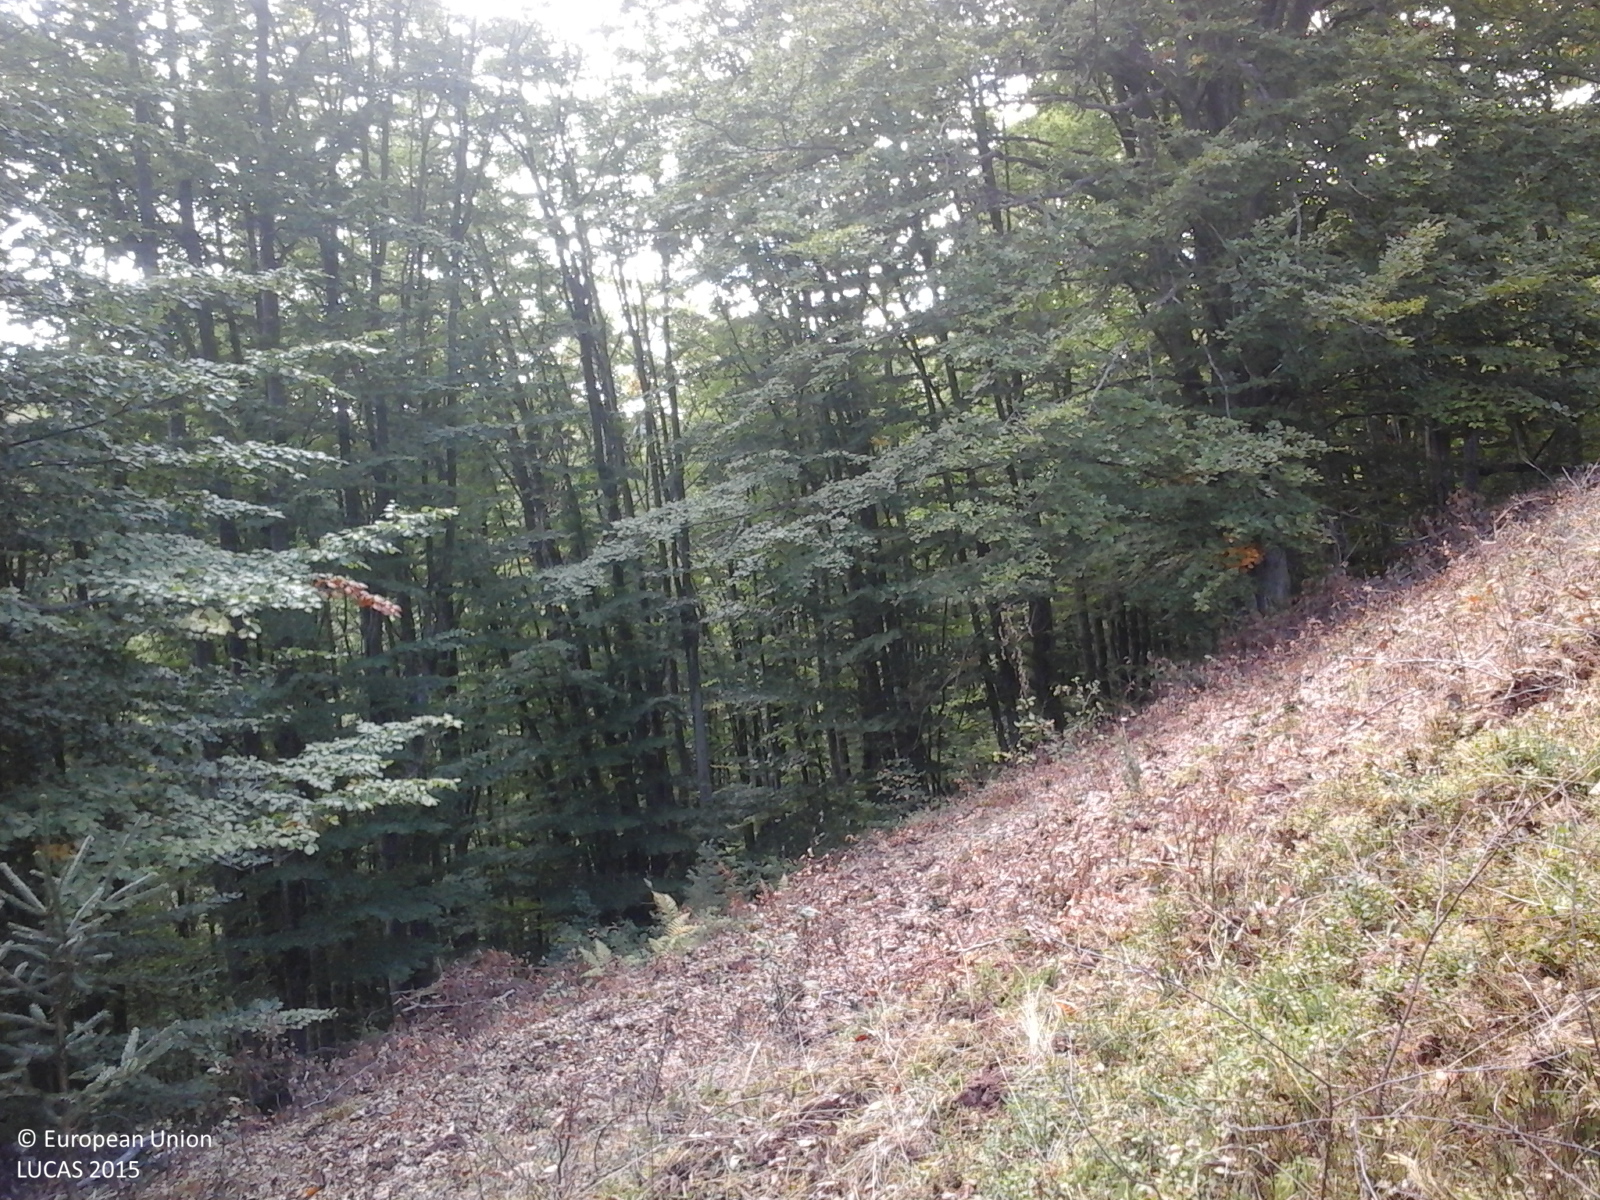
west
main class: Woodland
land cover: Broadleaved woodland
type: mesophytic deciduous forest
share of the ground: > 75 %
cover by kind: broadleaved forest trees 100 %
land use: Forestry
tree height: > 5 m
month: October
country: RO
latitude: 46.3876
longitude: 22.8913
